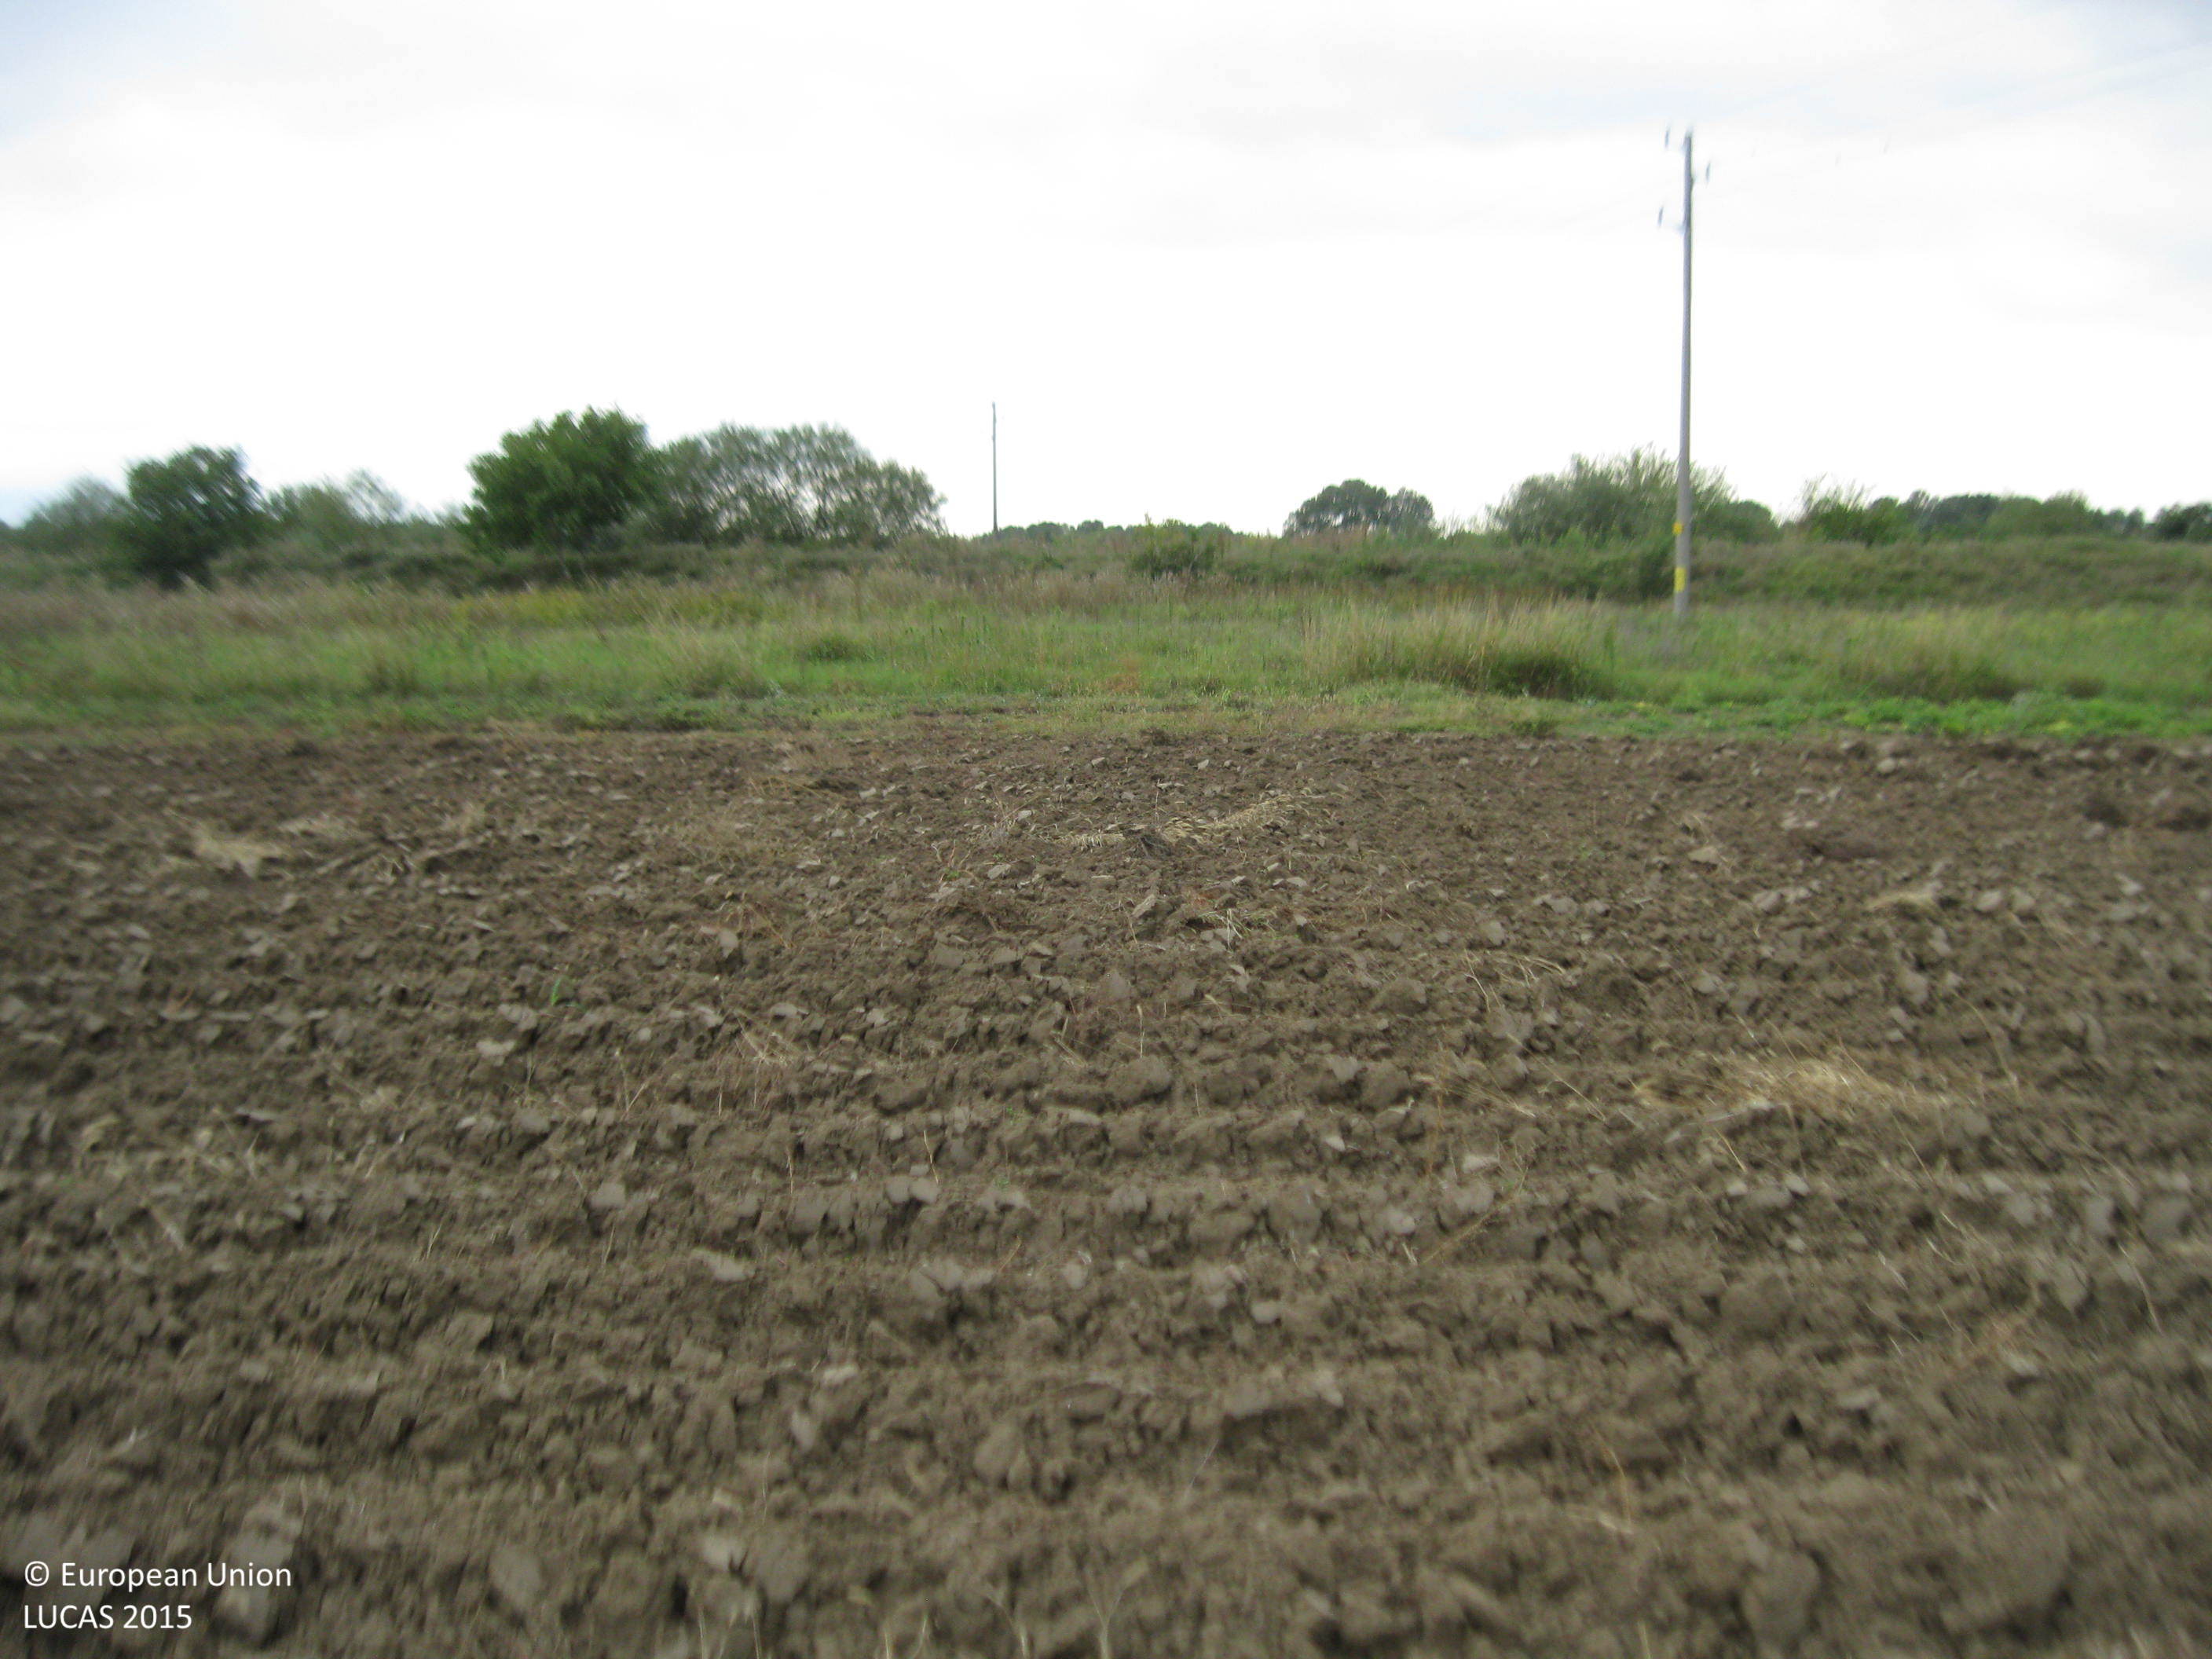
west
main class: Cropland
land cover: Common wheat
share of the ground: < 10 %
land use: Agriculture (excluding fallow land and kitchen gardens)
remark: Harvested field
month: September
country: BG
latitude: 42.1457
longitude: 25.0494
